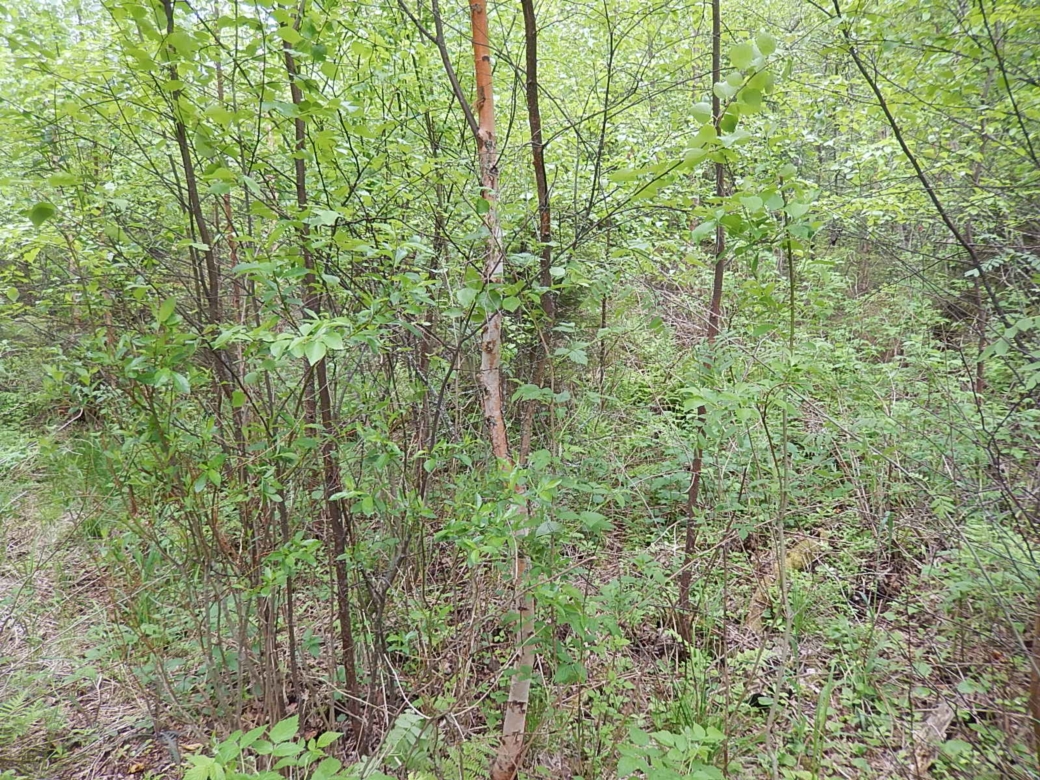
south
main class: Woodland
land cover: Pine dominated mixed woodland
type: boreal forest
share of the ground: > 75 %
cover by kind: broadleaved forest trees 50 %, coniferous forest trees 40 %, shrubs 5 %, herbaceous plants 5 %
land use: Forestry
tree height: > 5 m
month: June
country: FI
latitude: 61.7796
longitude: 21.5944
